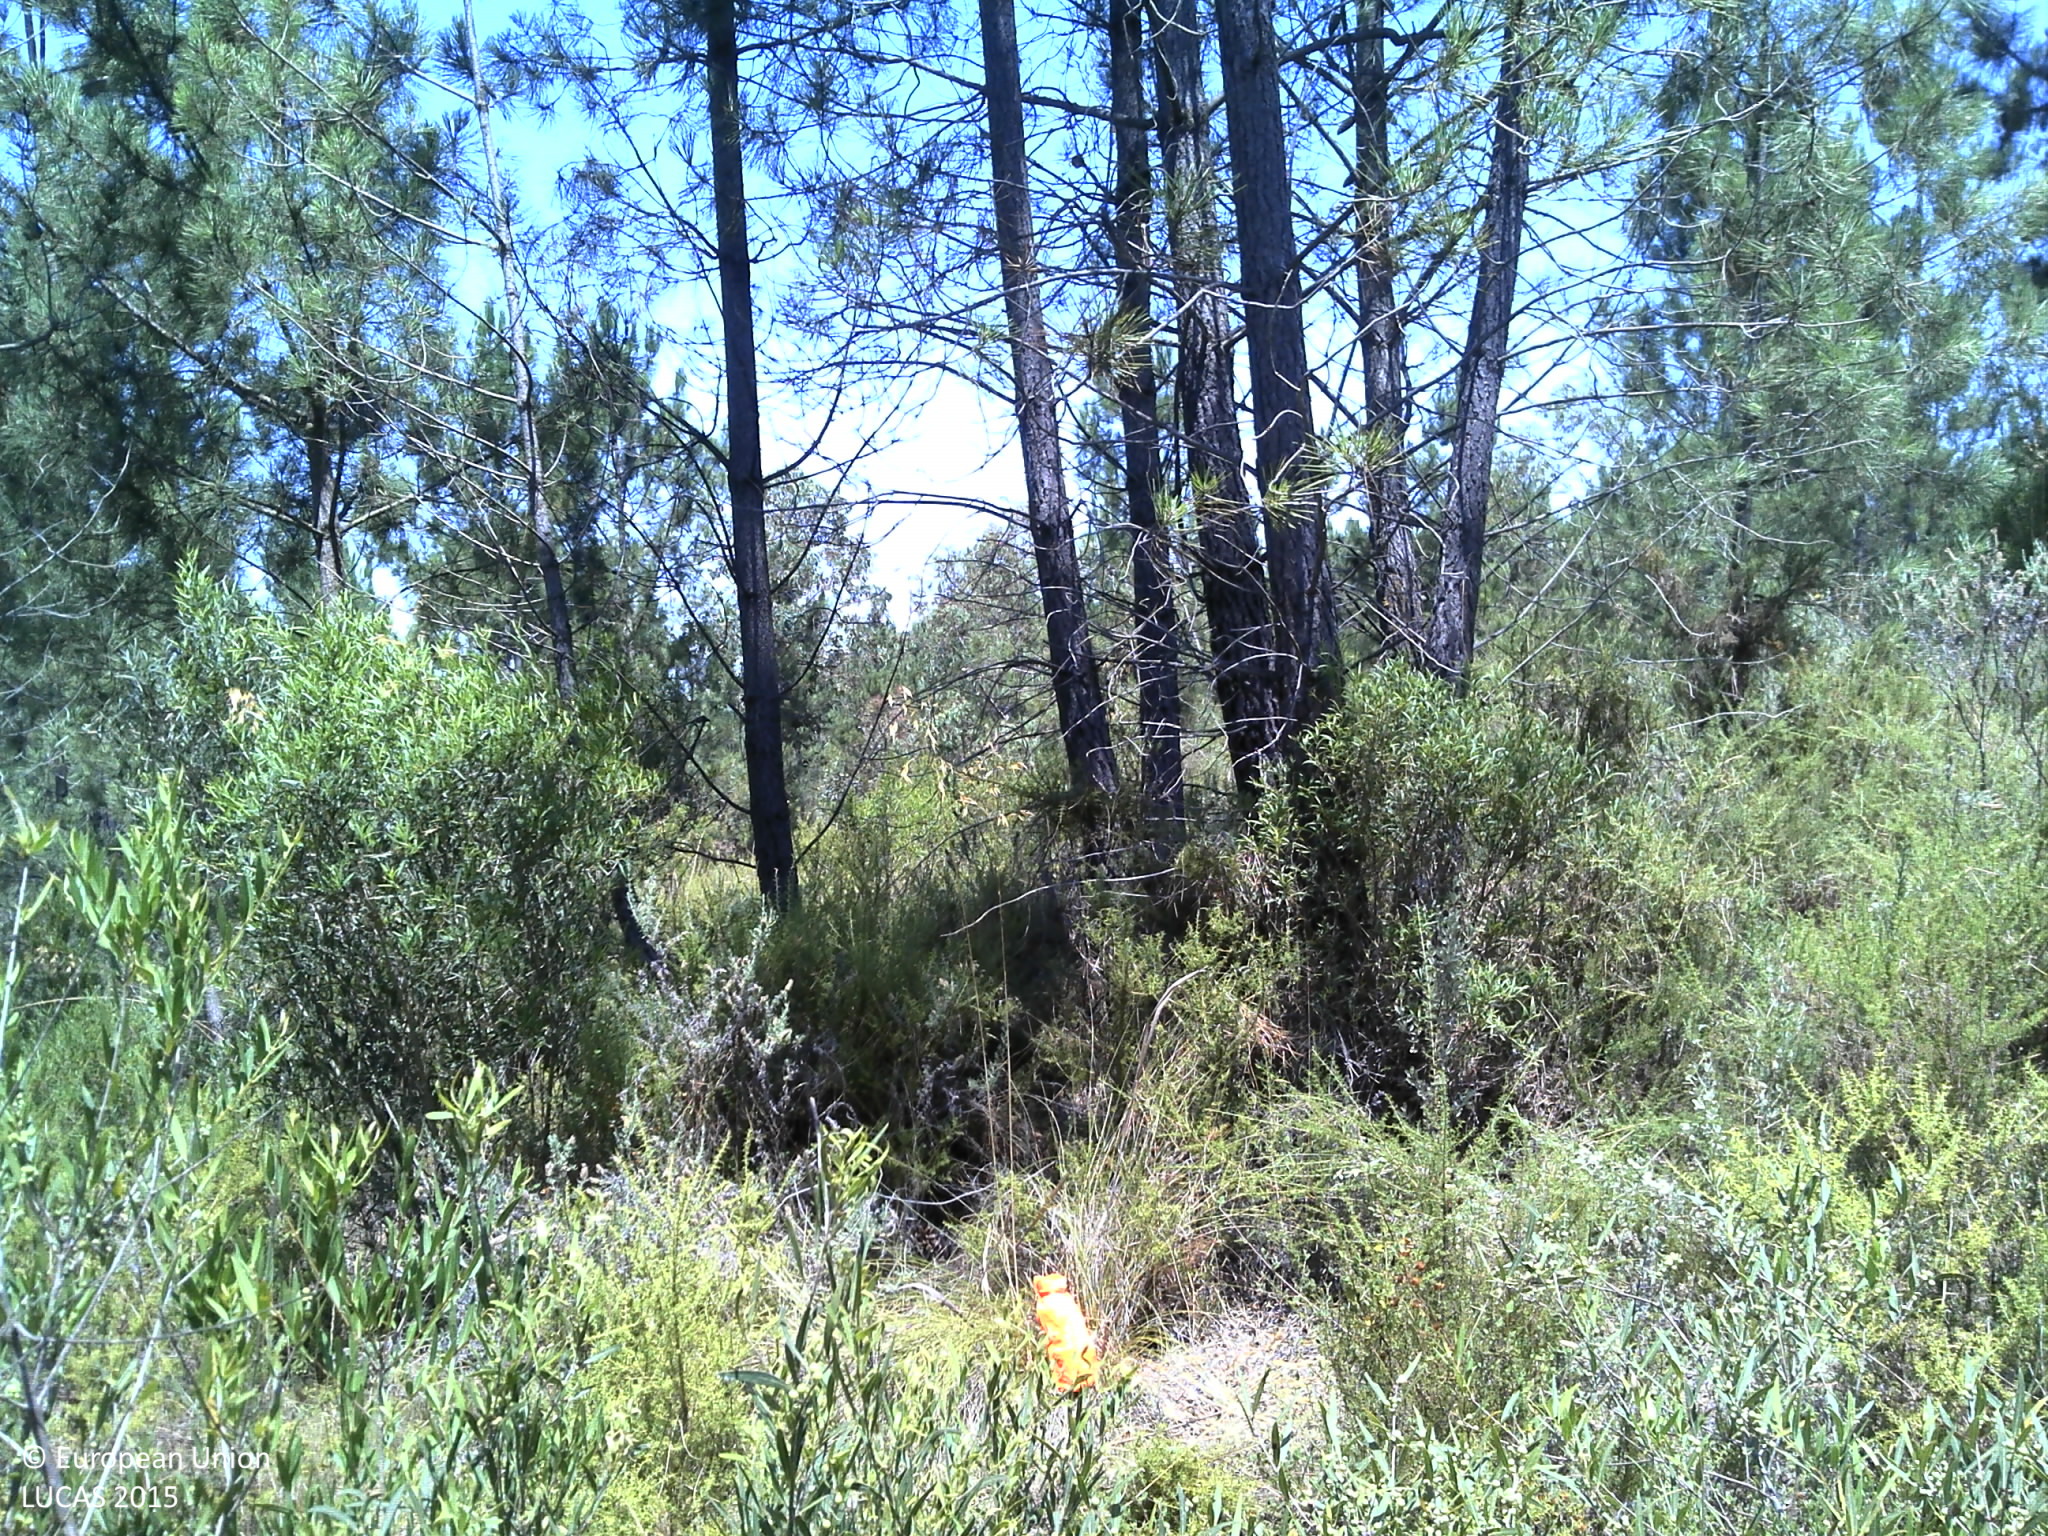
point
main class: Woodland
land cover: Pine dominated coniferous woodland
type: coniferous forest of the mediterranean region
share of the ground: 25 - 50 %
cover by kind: coniferous forest trees 40 %, shrubs 30 %, unconsolidated bare surface 25 %, herbaceous plants 5 %
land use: Forestry
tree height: > 5 m
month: June
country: PT
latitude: 38.6027
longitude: -9.1457
